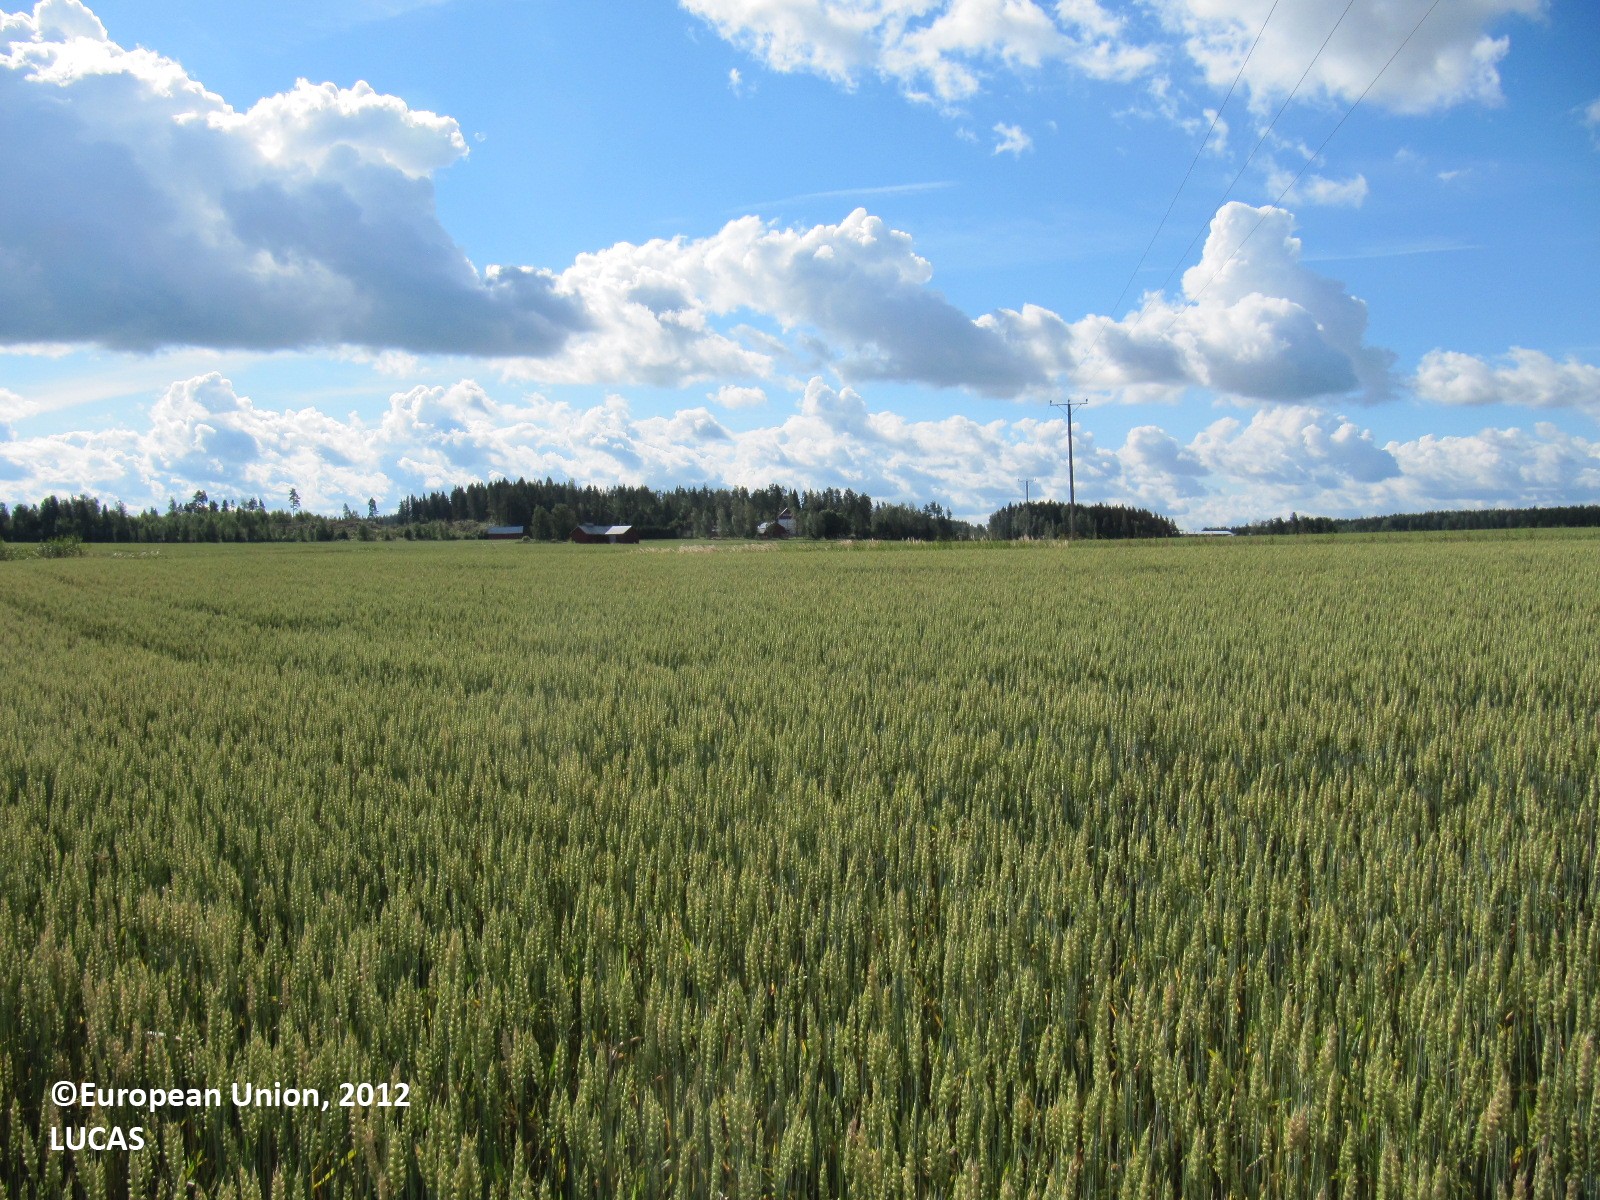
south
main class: Cropland
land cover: Common wheat
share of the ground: > 75 %
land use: Agriculture (excluding fallow land and kitchen gardens)
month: August
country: FI
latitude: 60.5103
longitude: 23.1748
